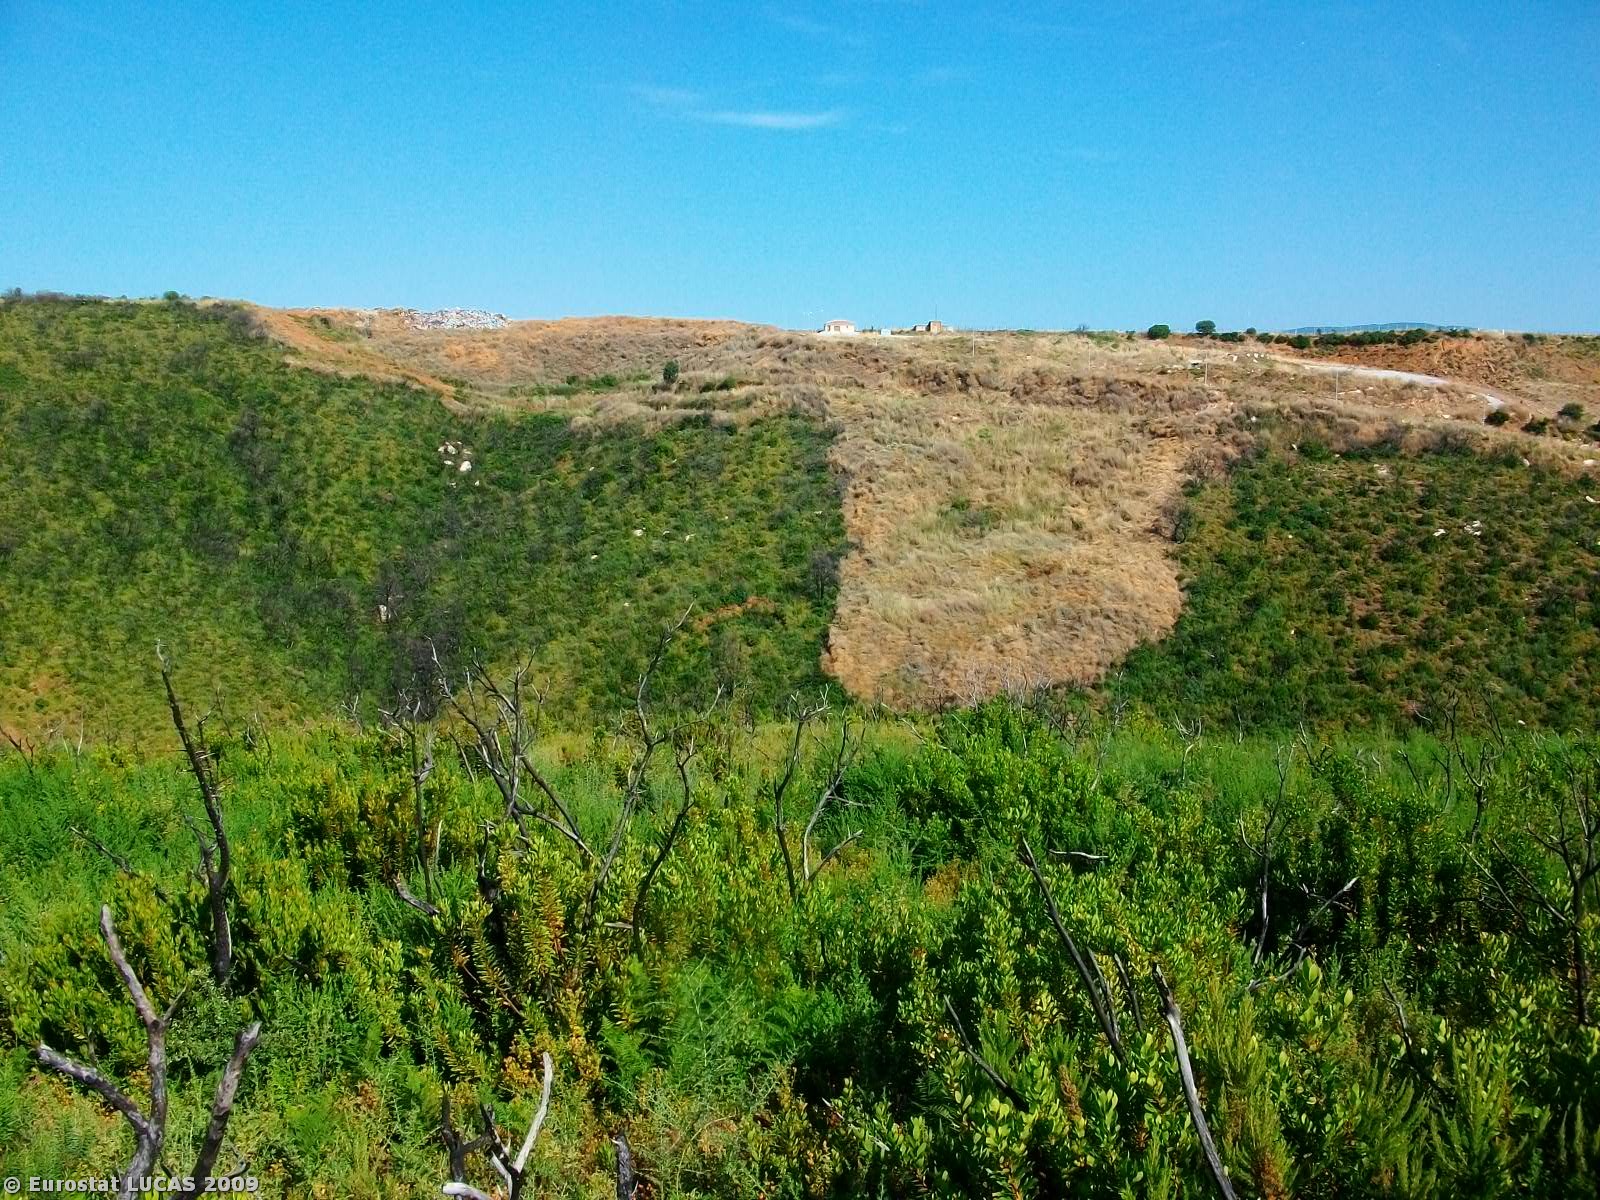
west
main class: Shrubland
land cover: Shrubland without tree cover
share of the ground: > 75 %
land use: Unused
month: June
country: GR
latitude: 39.2559
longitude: 23.2389
